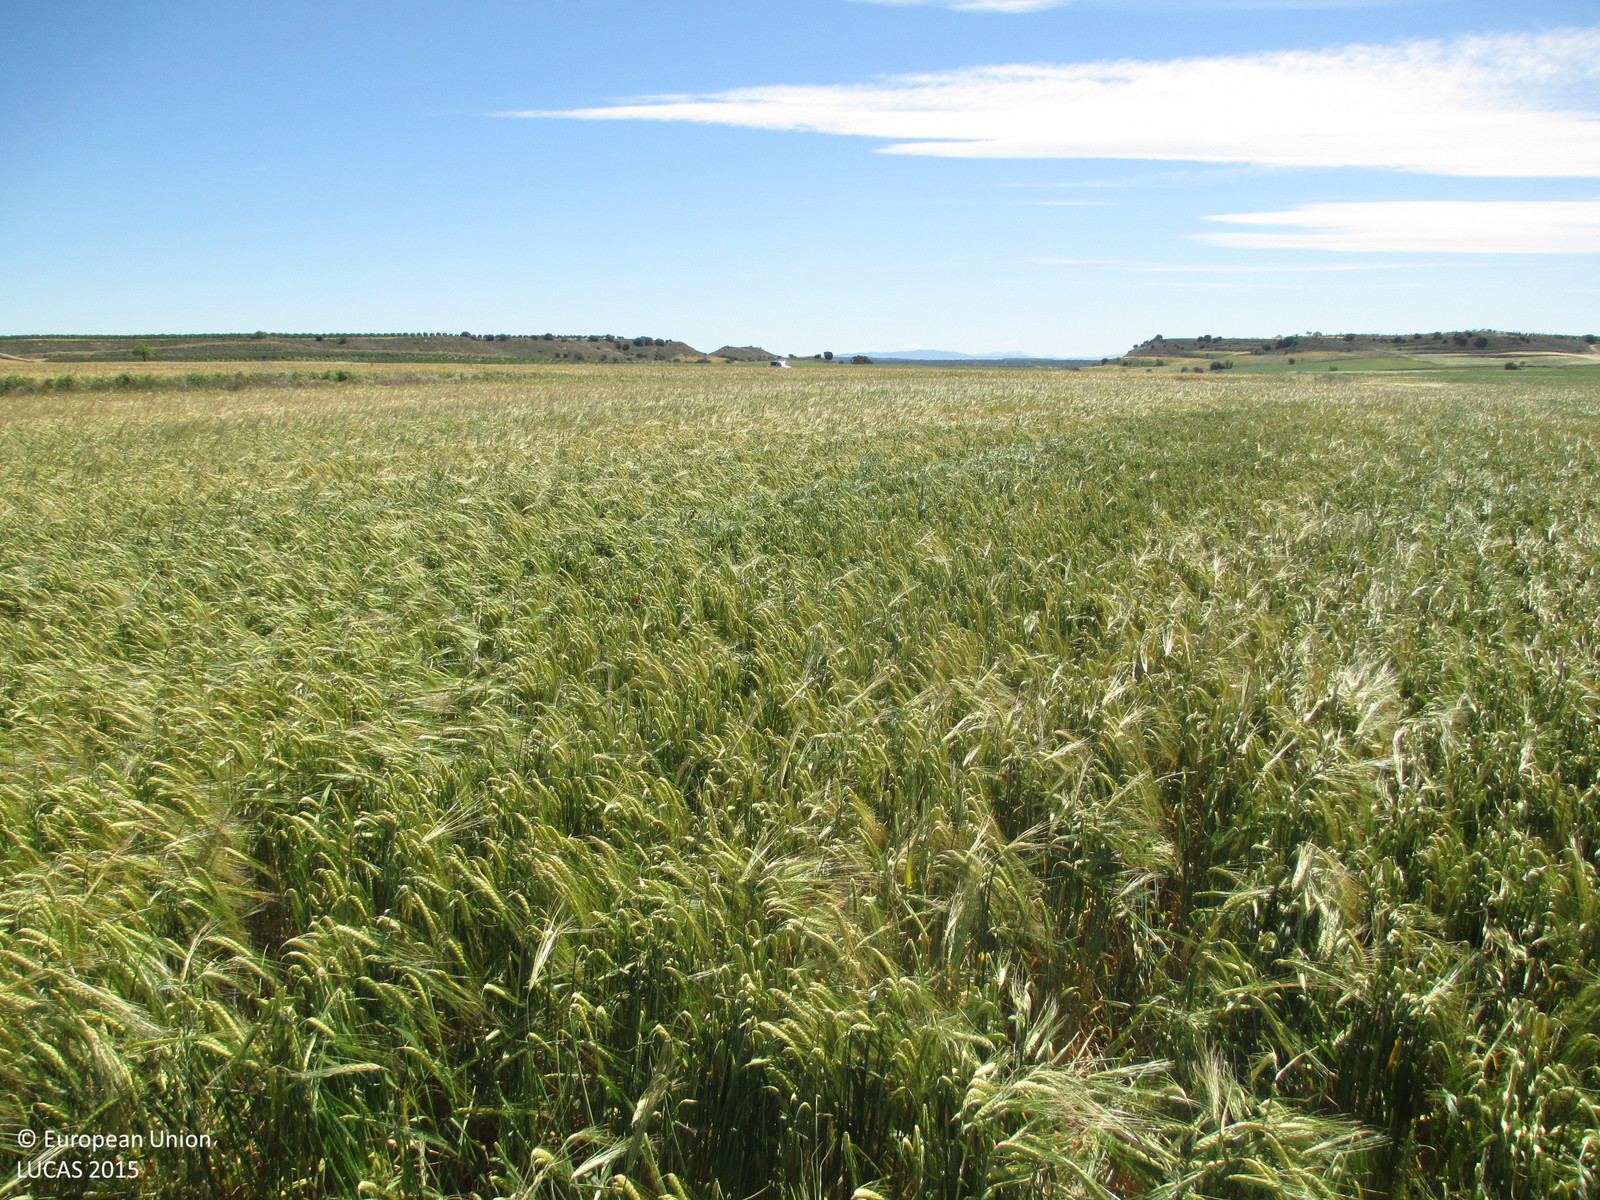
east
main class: Cropland
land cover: Barley
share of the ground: > 75 %
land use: Agriculture (excluding fallow land and kitchen gardens)
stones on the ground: < 10 %
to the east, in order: Barley; Shruby margins; Barley; Grass margins; Tracks; Shruby margins; Dry pulses
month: May
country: ES
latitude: 42.0186
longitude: -0.2977
